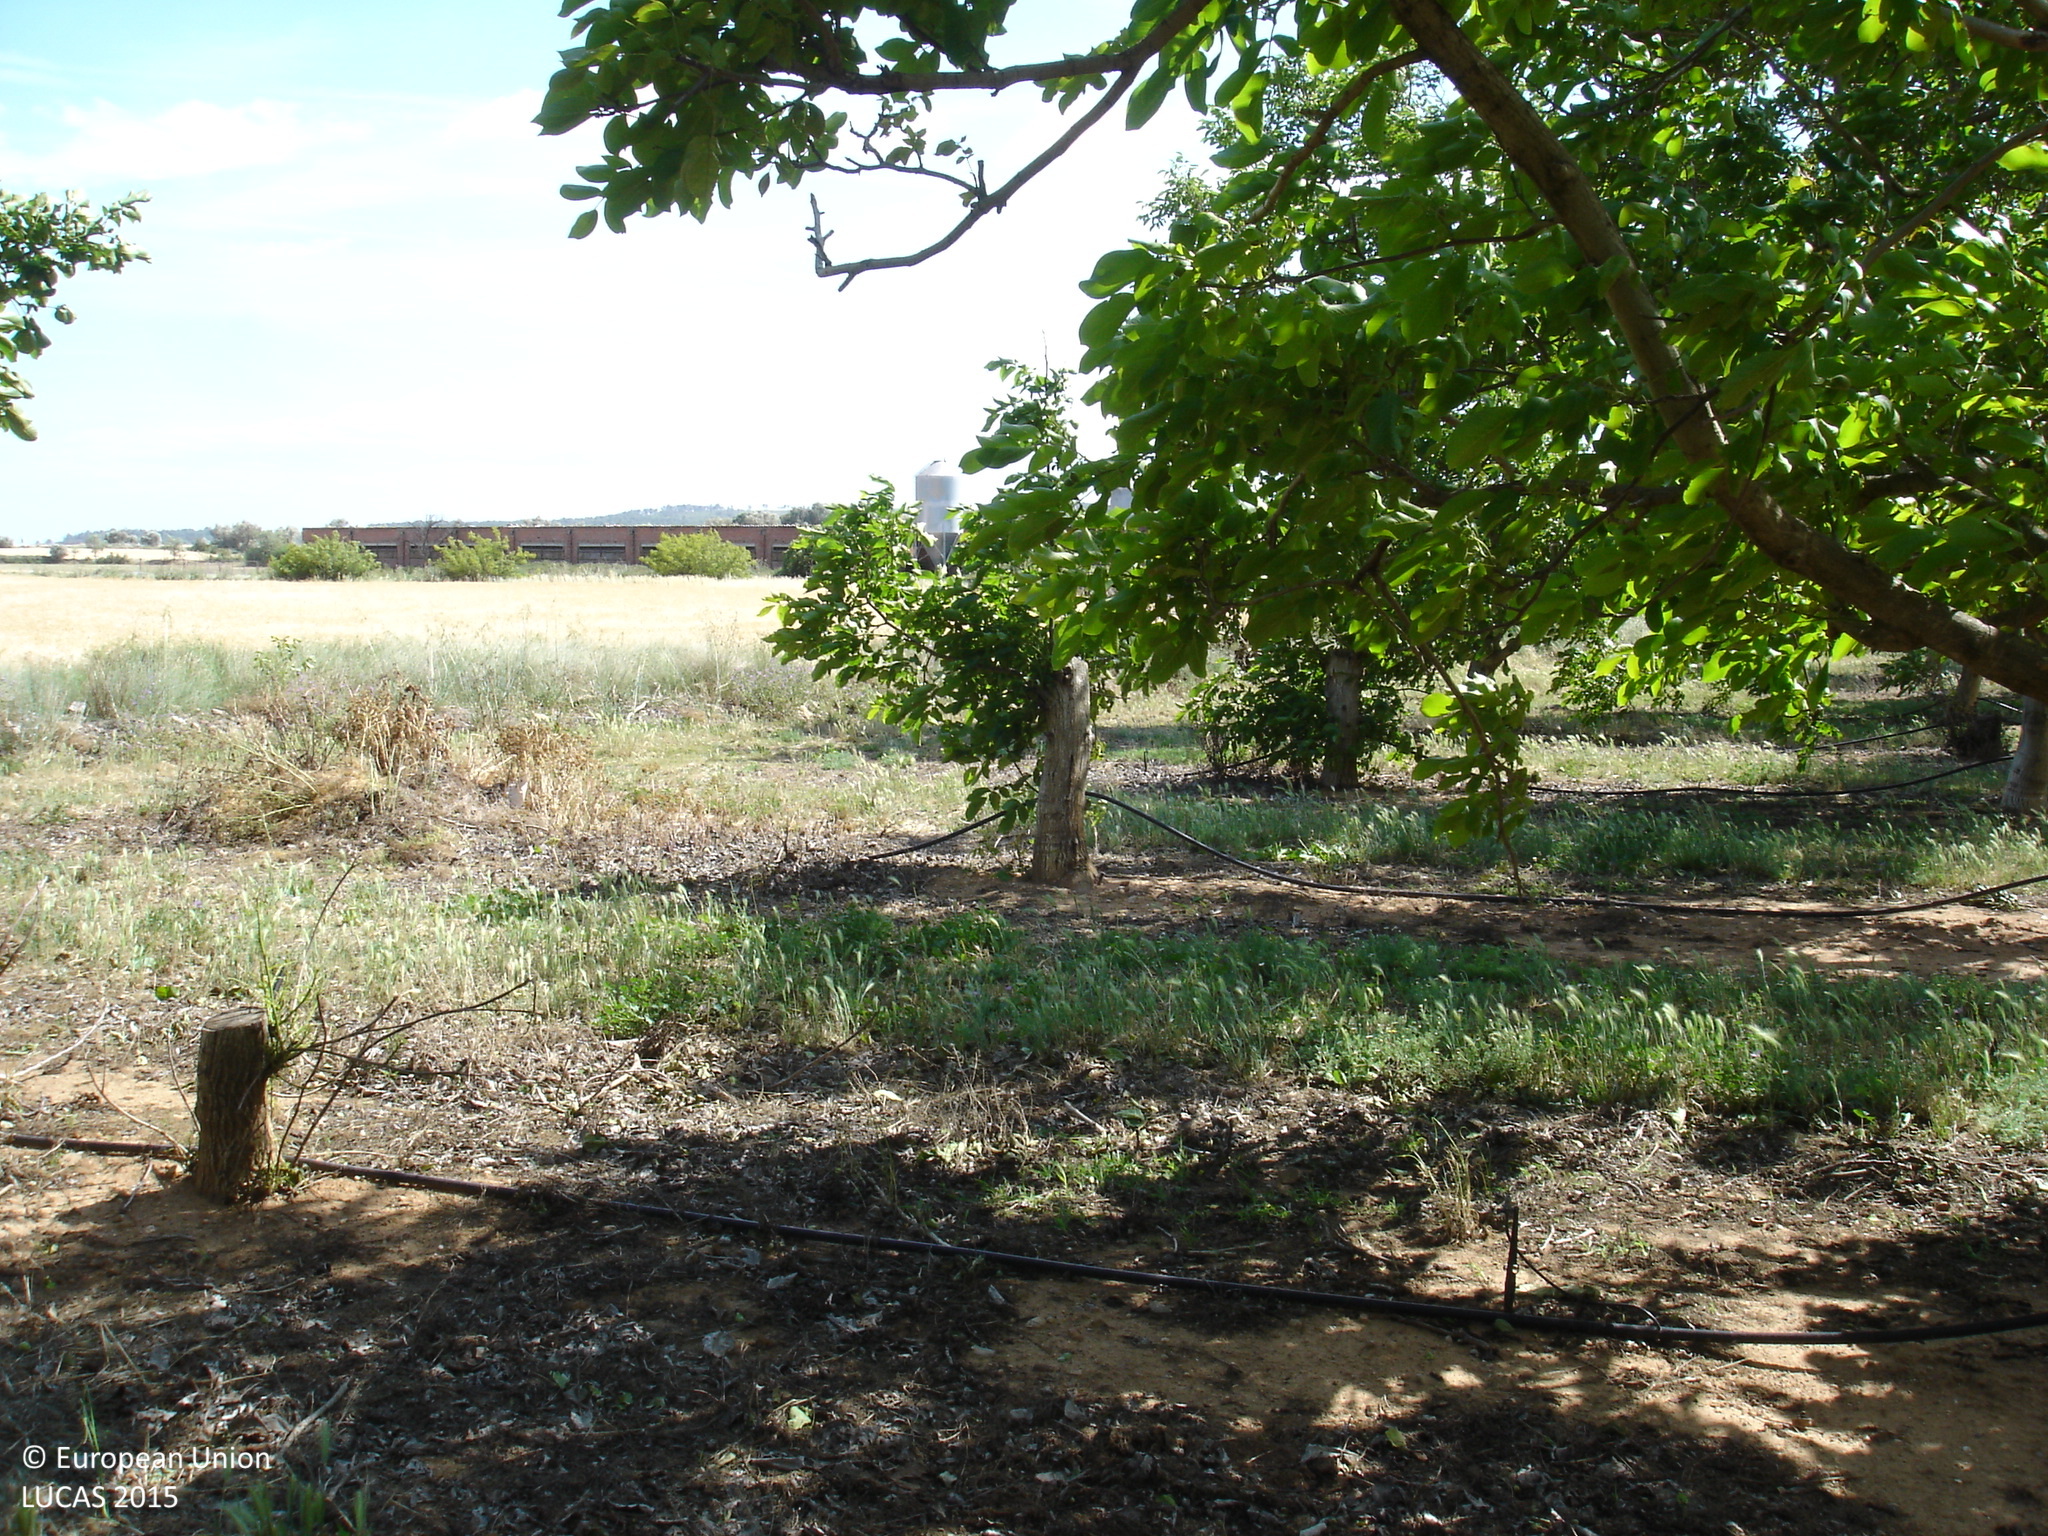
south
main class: Cropland
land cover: Nuts trees
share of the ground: > 75 %
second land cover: Spontaneously vegetated surfaces
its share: 25 - 50 %
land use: Agriculture (excluding fallow land and kitchen gardens)
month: May
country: ES
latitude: 42.1438
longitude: 3.0574
